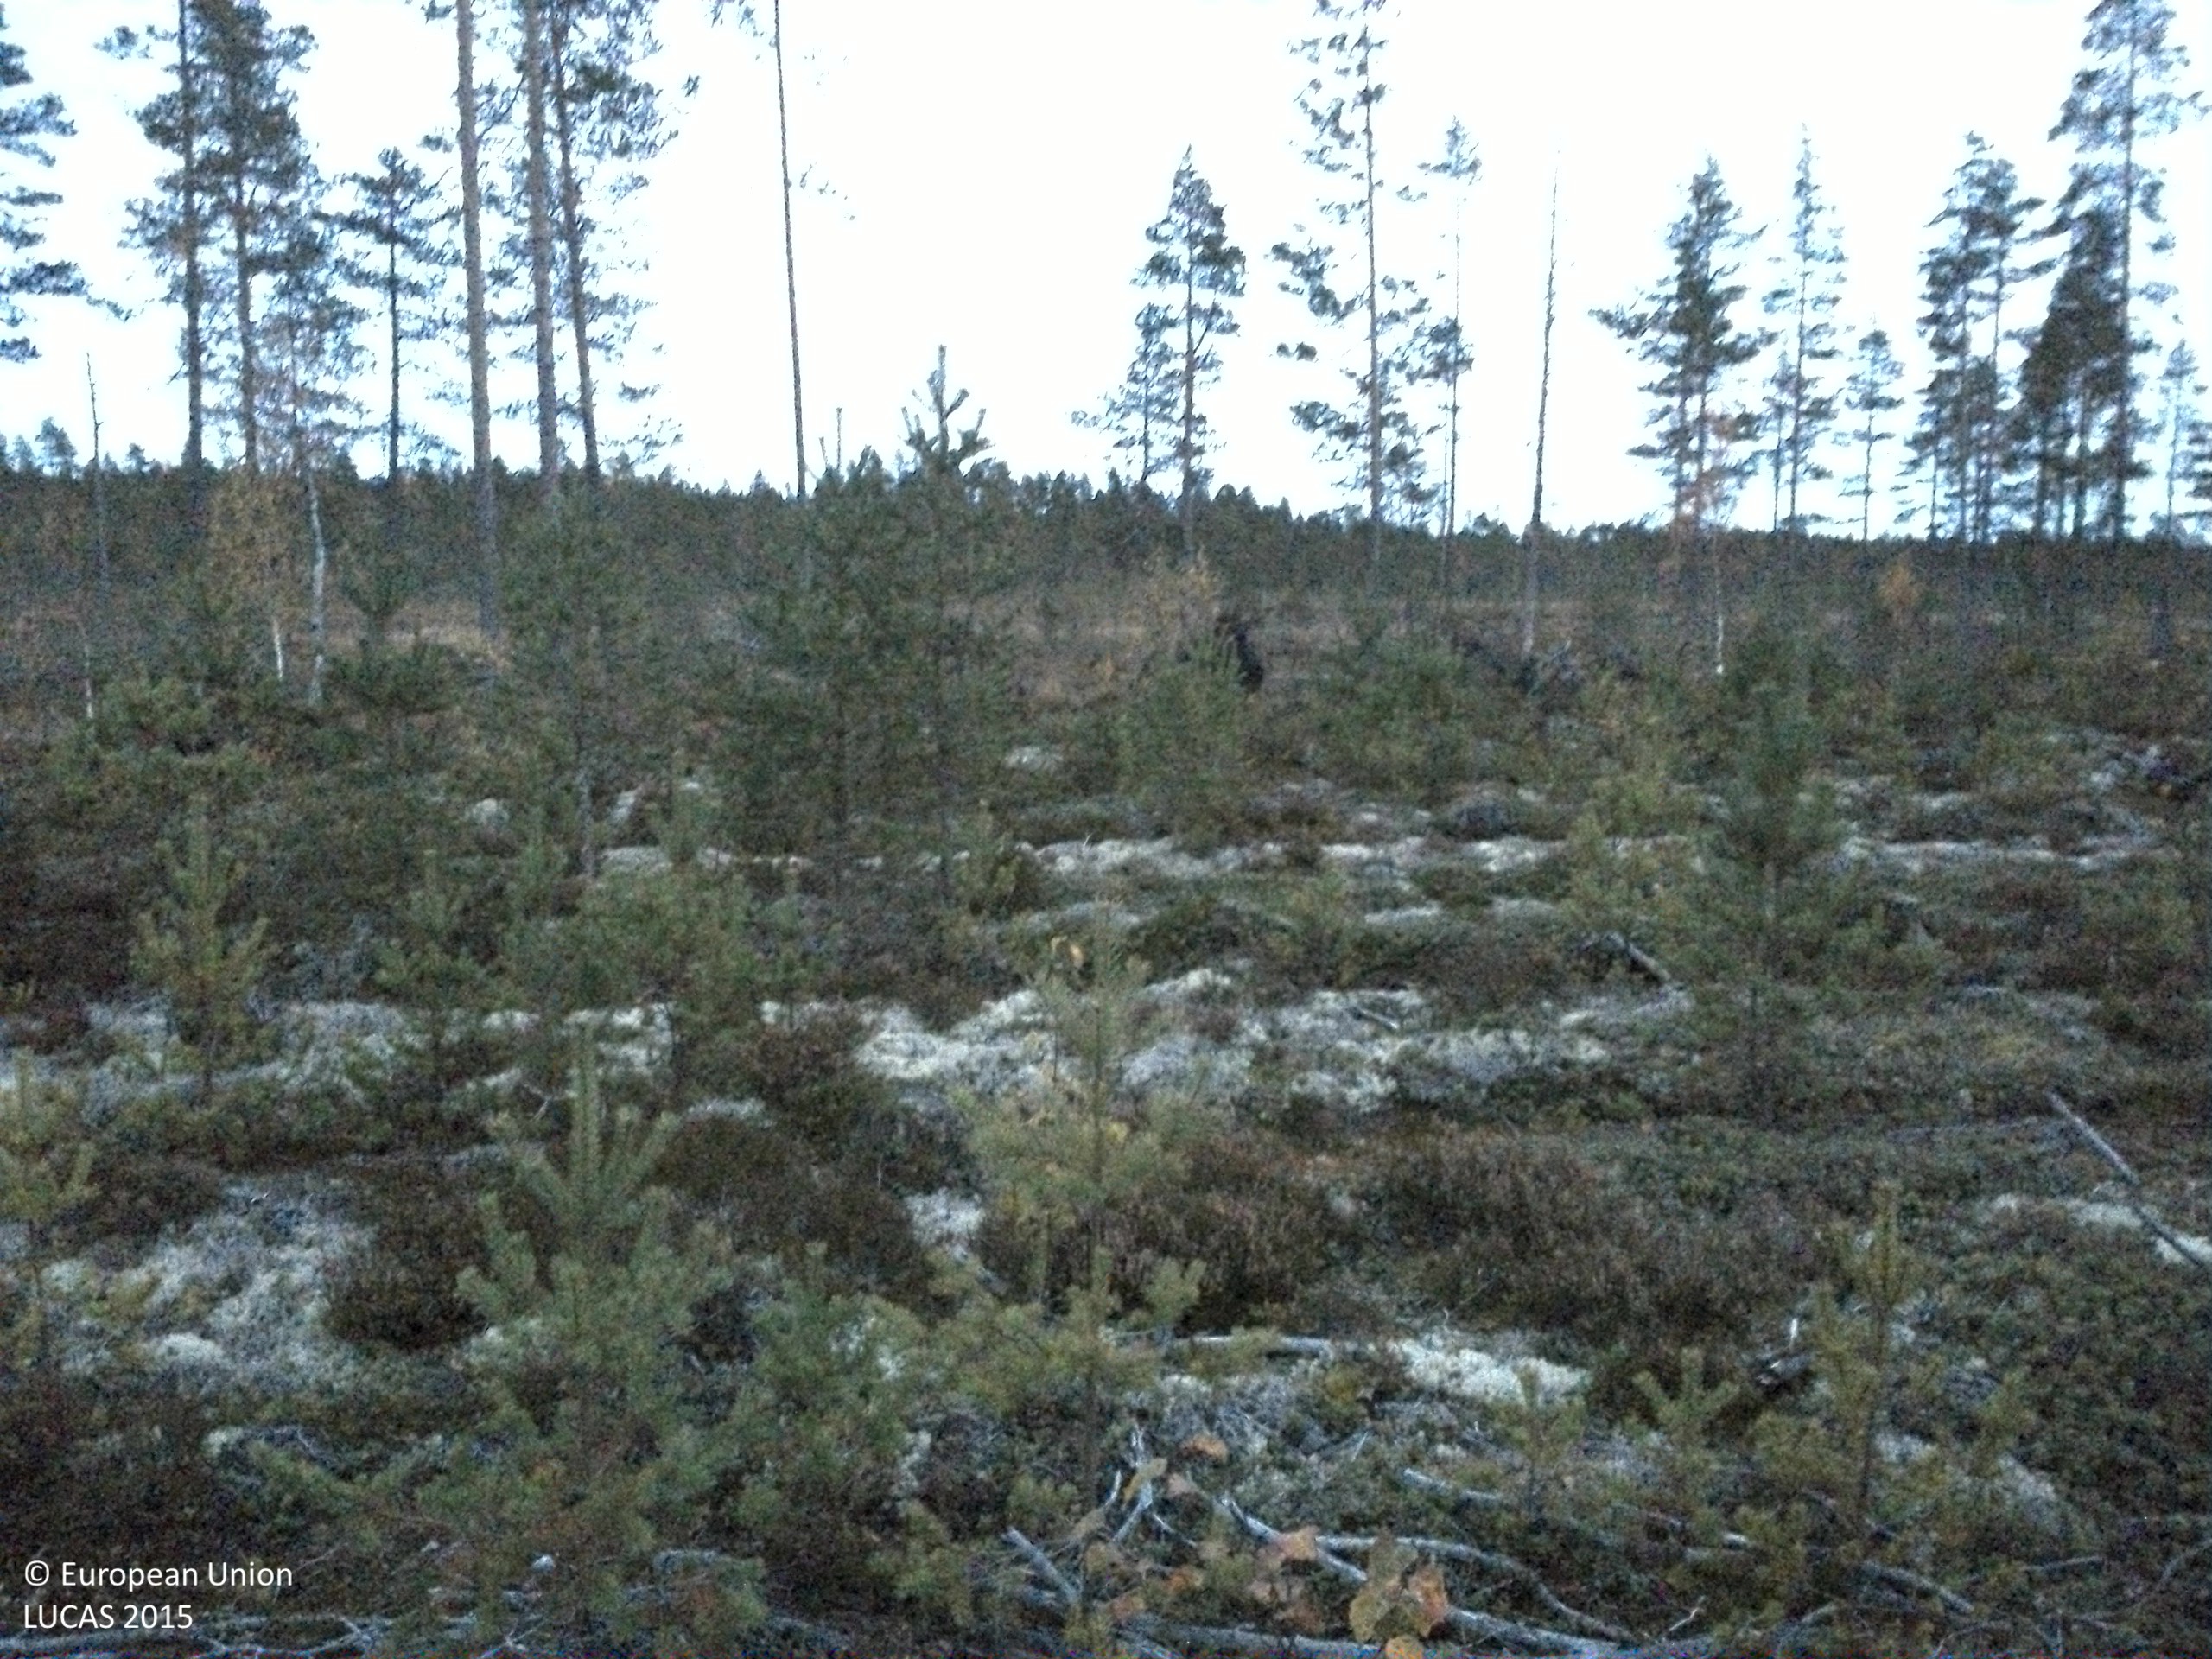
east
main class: Woodland
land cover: Pine dominated coniferous woodland
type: boreal forest
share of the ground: 25 - 50 %
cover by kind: shrubs 40 %, coniferous forest trees 35 %, lichens and mosses 10 %, consolidated bare surface 10 %, broadleaved forest trees 5 %
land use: Forestry
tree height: < 5 m
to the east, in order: Pine dominated coniferous woodland; Peatbogs; Inland fresh water bodies; Peatbogs; Pine dominated coniferous woodland
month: October
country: SE
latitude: 61.3343
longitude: 15.0866
